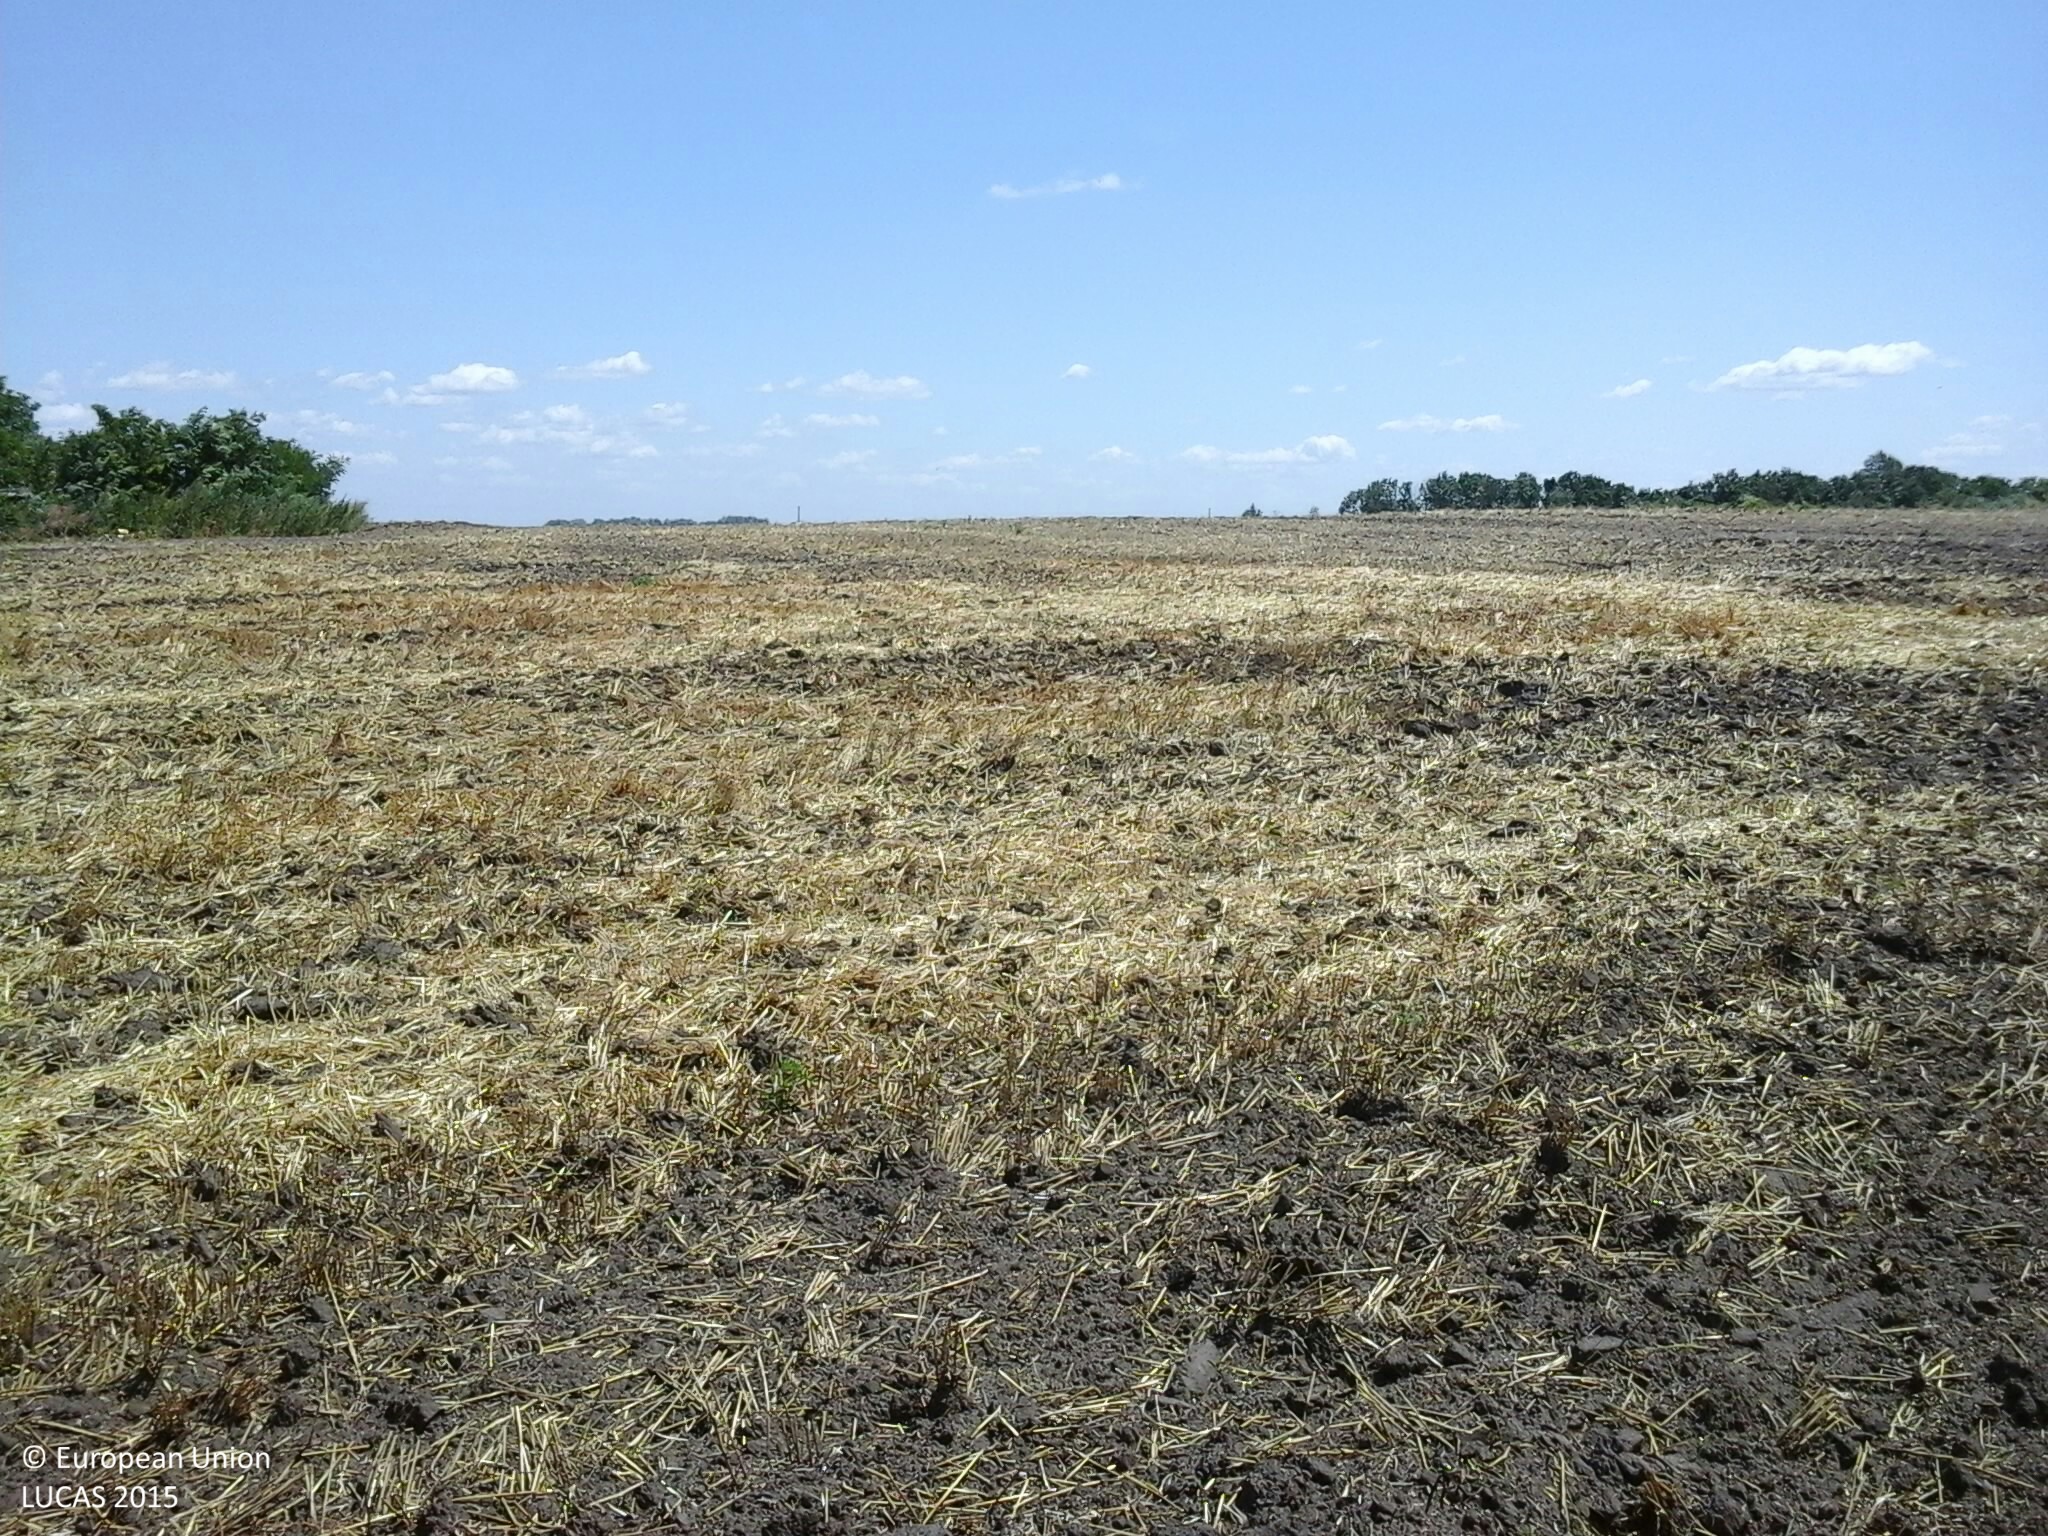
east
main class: Cropland
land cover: Common wheat
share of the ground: < 10 %
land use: Agriculture (excluding fallow land and kitchen gardens)
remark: Harvested field
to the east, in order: Common wheat
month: July
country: HU
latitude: 46.6370
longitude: 20.0684
